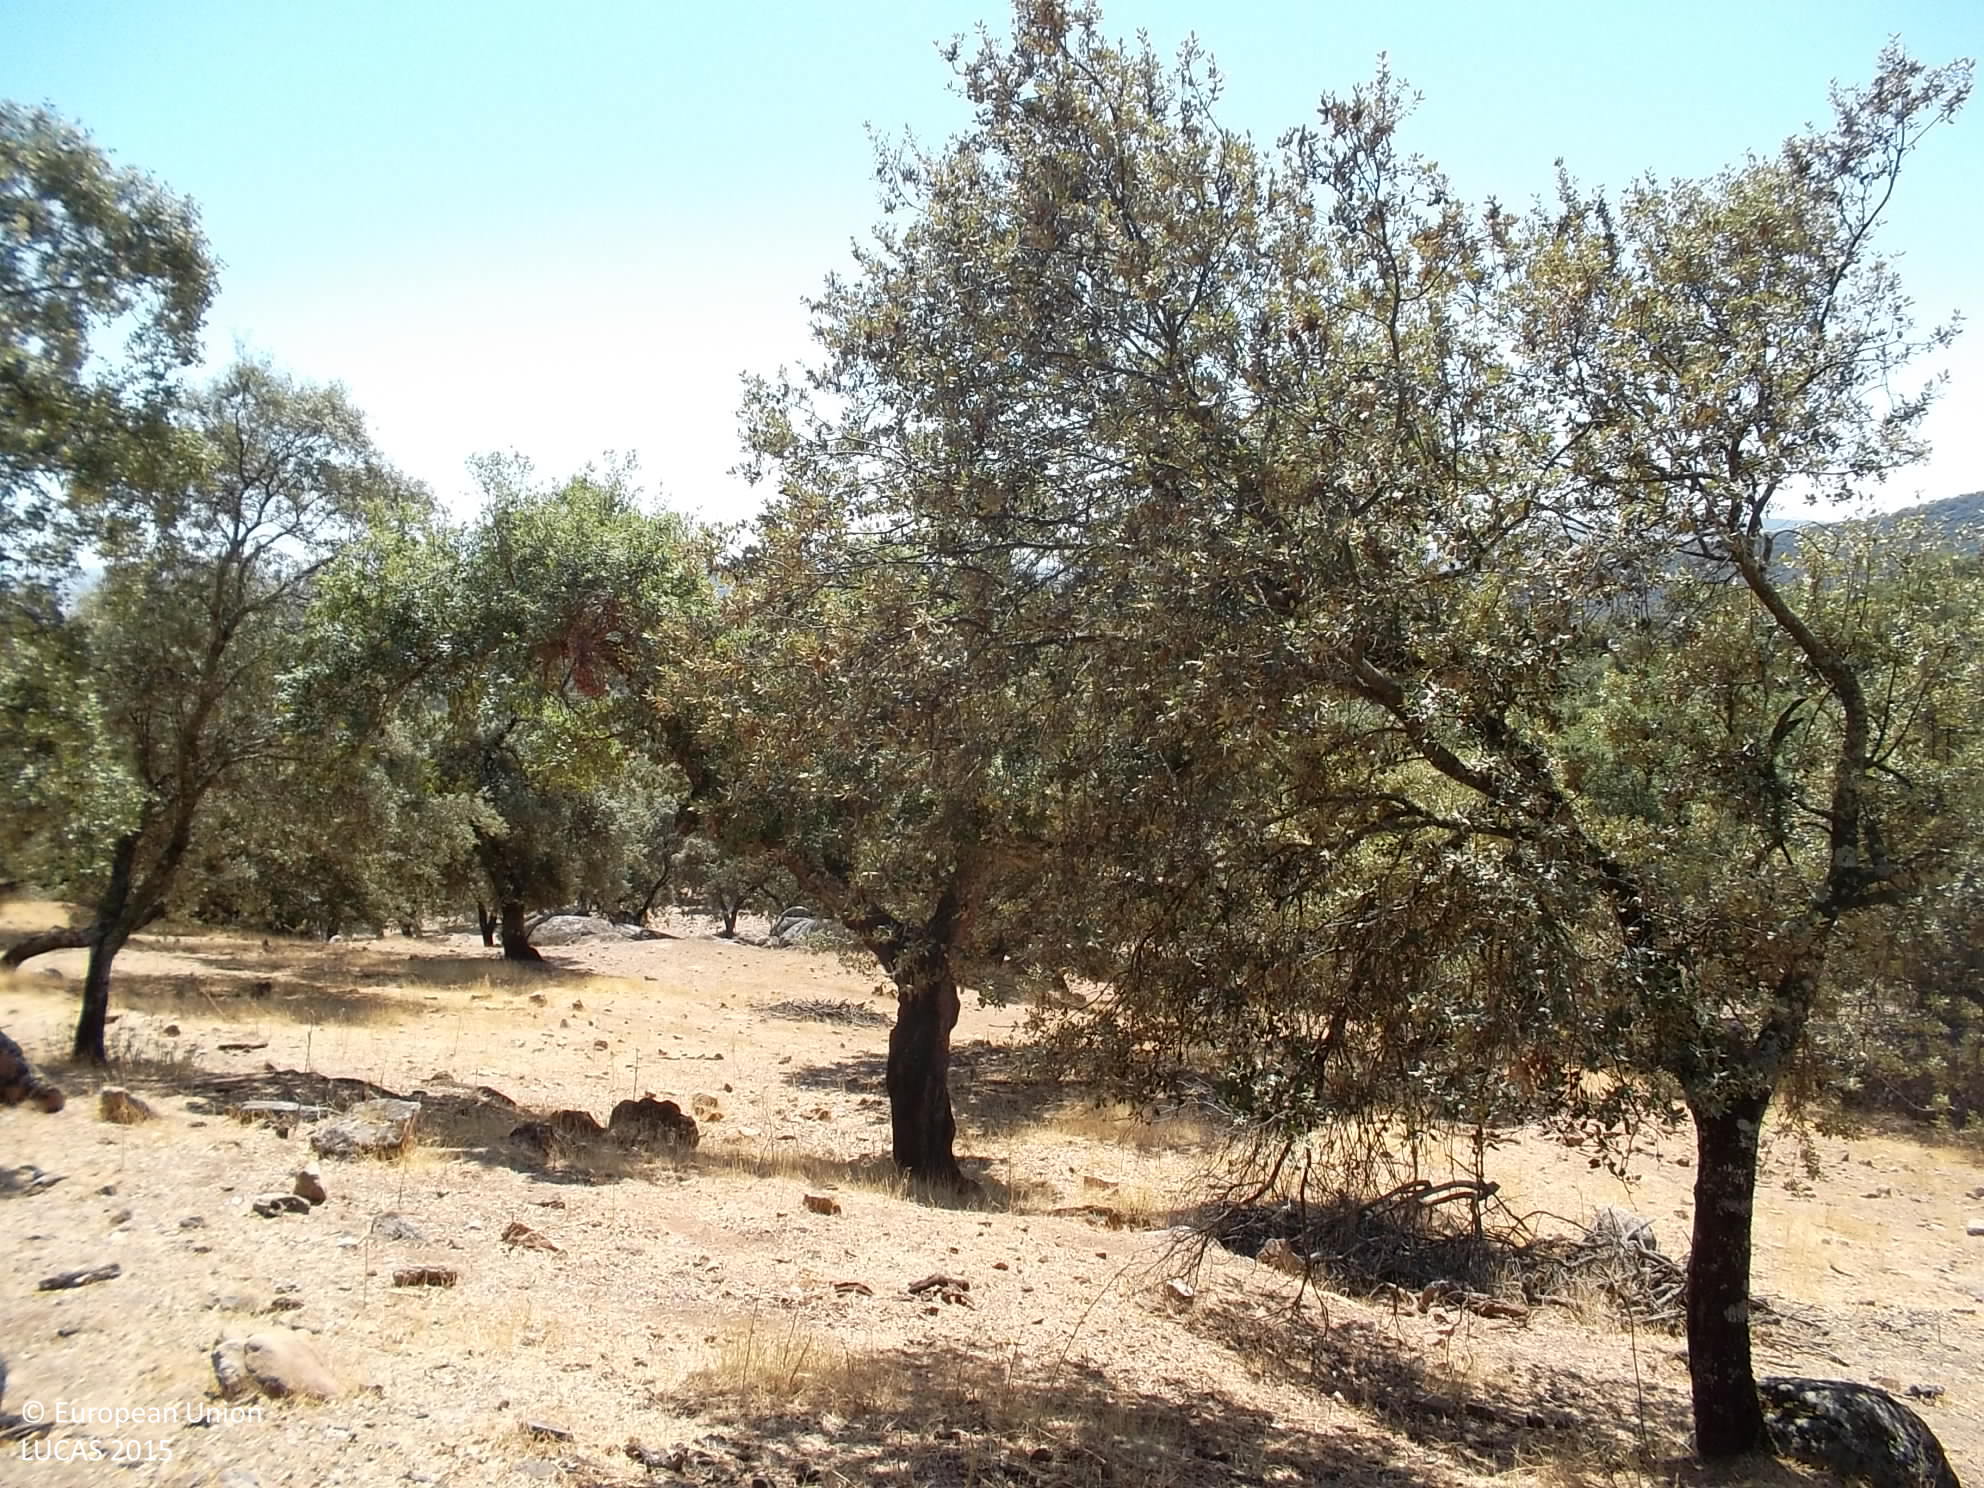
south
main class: Woodland
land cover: Broadleaved woodland
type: broadleaved evergreen forest
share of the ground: 25 - 50 %
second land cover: Grassland without tree/shrub cover
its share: 25 - 50 %
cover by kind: herbaceous plants 45 %, broadleaved forest trees 40 %, consolidated bare surface 15 %
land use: Forestry
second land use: Agriculture (excluding fallow land and kitchen gardens)
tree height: < 5 m
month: August
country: ES
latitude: 38.4546
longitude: -6.7068
